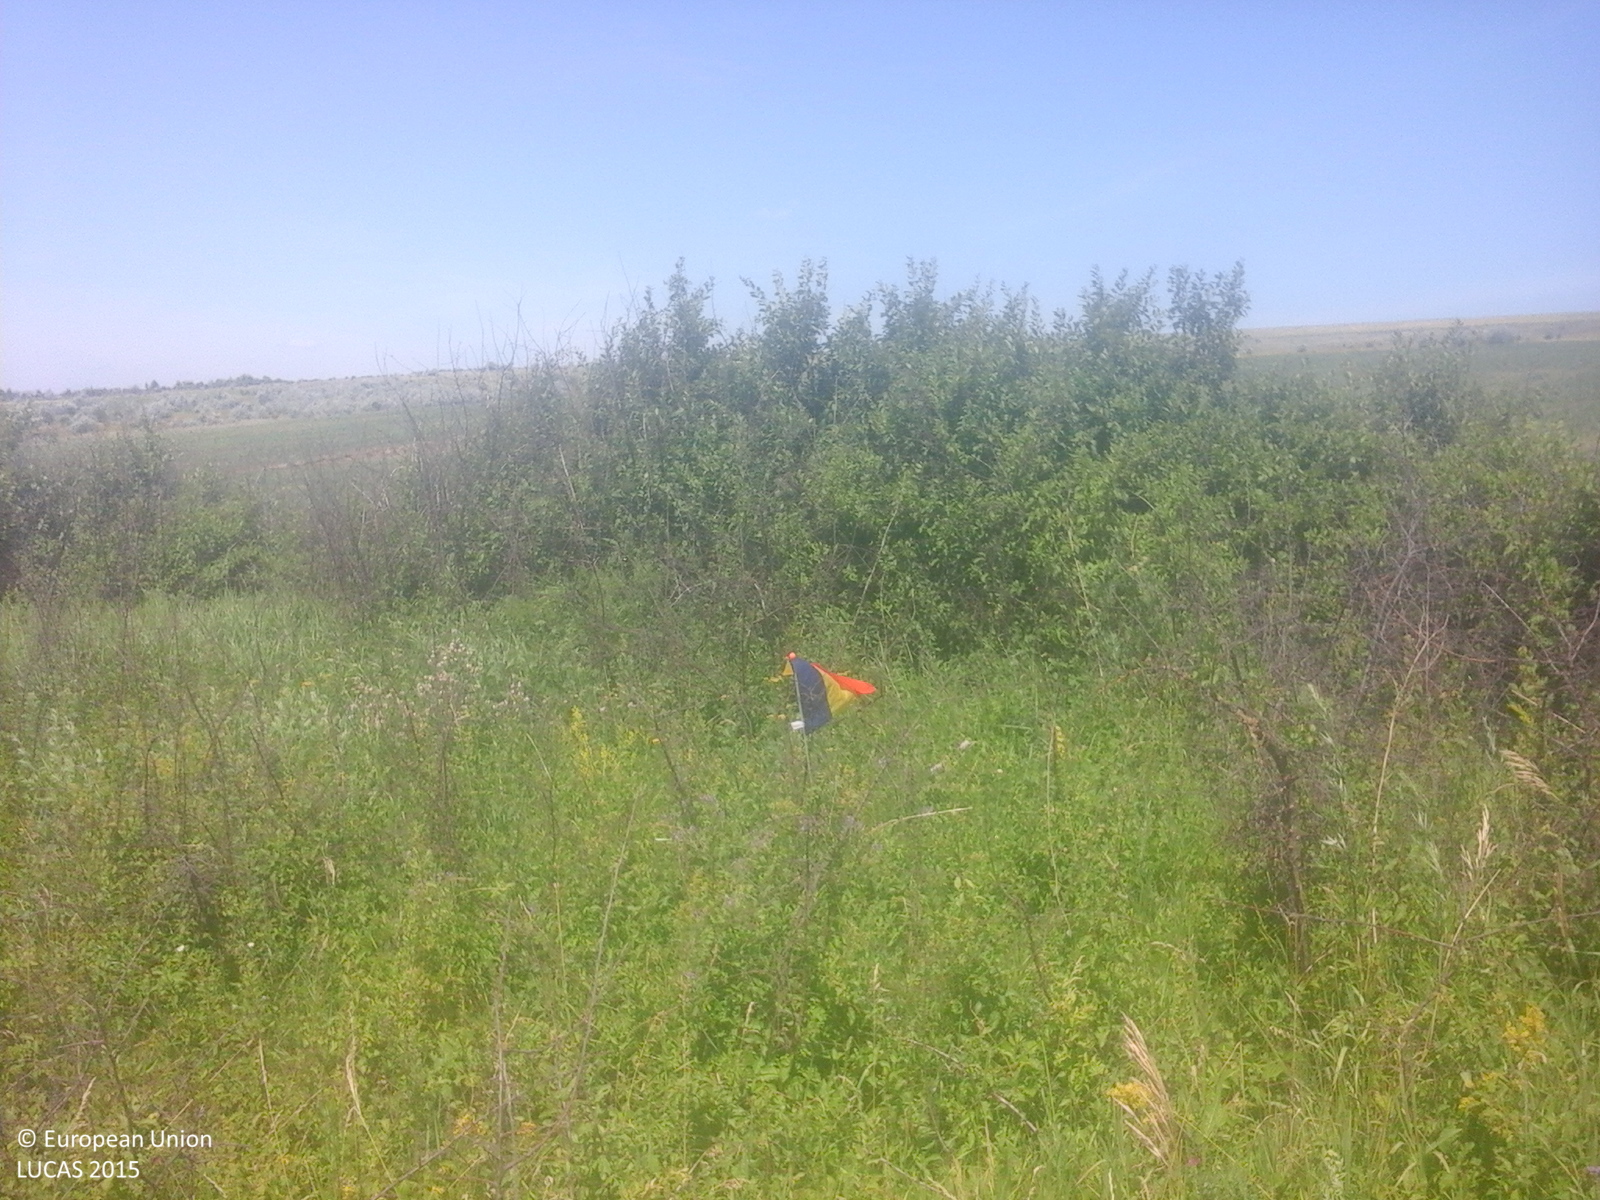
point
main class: Shrubland
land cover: Shrubland without tree cover
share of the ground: > 75 %
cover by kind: shrubs 80 %, herbaceous plants 20 %
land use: Semi-natural and natural areas not in use
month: June
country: RO
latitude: 47.9176
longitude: 26.8965
